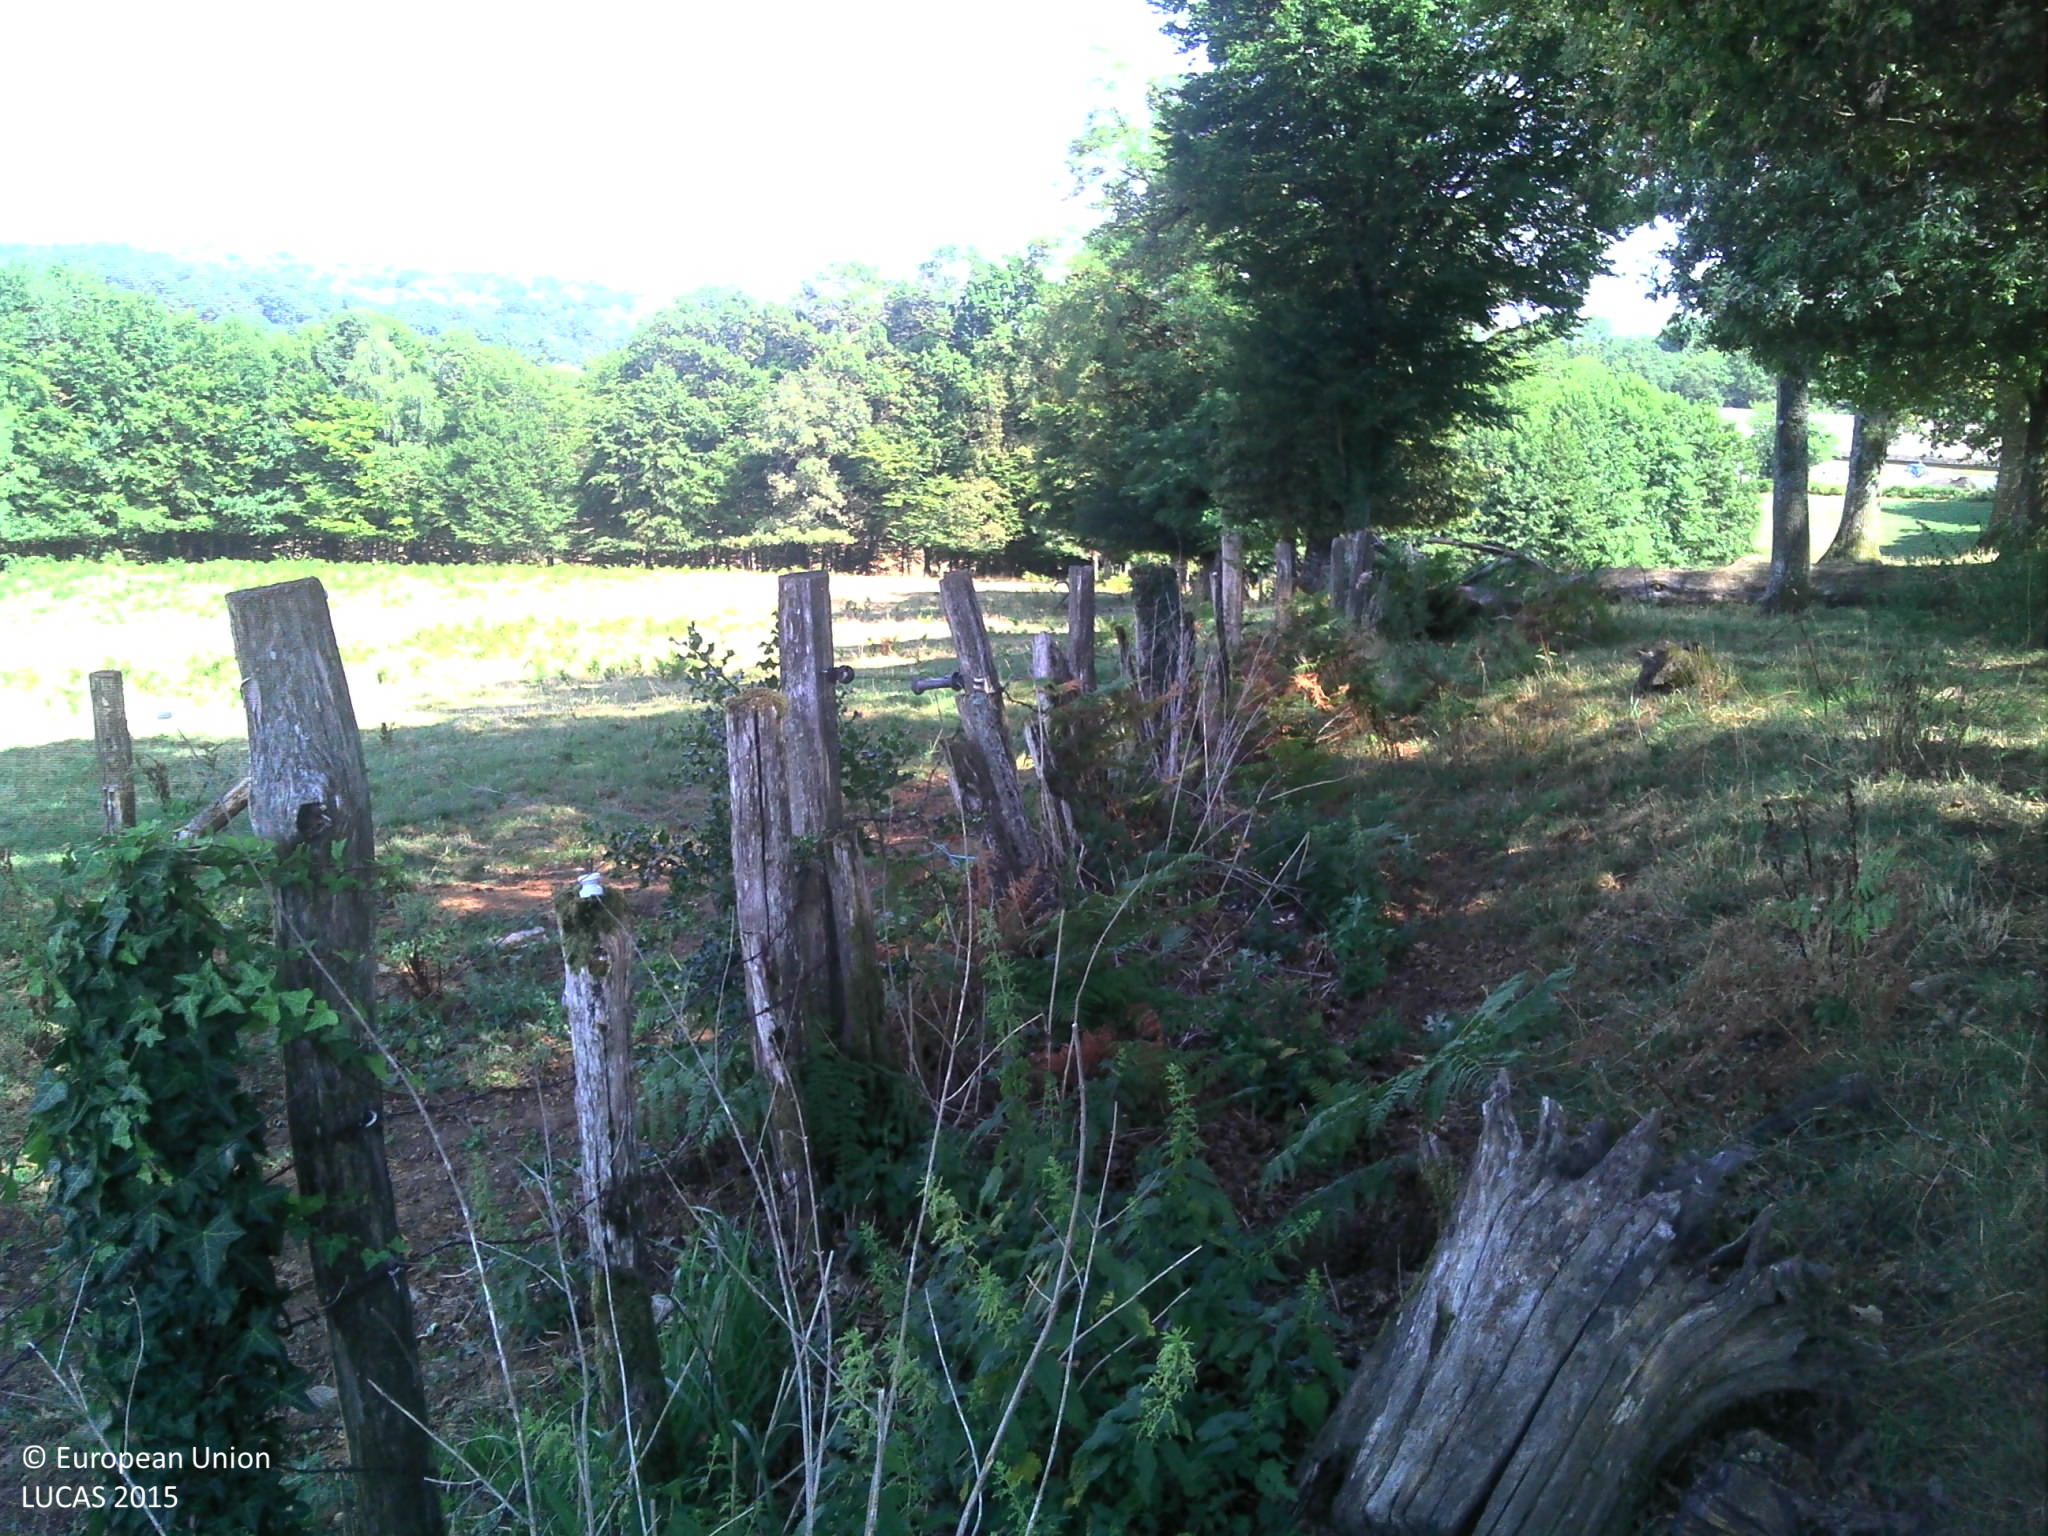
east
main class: Grassland
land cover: Grassland without tree/shrub cover
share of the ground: > 75 %
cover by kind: herbaceous plants 100 %
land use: Agriculture (excluding fallow land and kitchen gardens)
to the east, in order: Grassland without tree/shrub cover; Fences; Grassland without tree/shrub cover; Fences; Broadleaved woodland; Fences; Grassland without tree/shrub cover; Fences; Broadleaved woodland; Fences; Grassland without tree/shrub cover
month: August
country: FR
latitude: 45.3750
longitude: 1.6823
